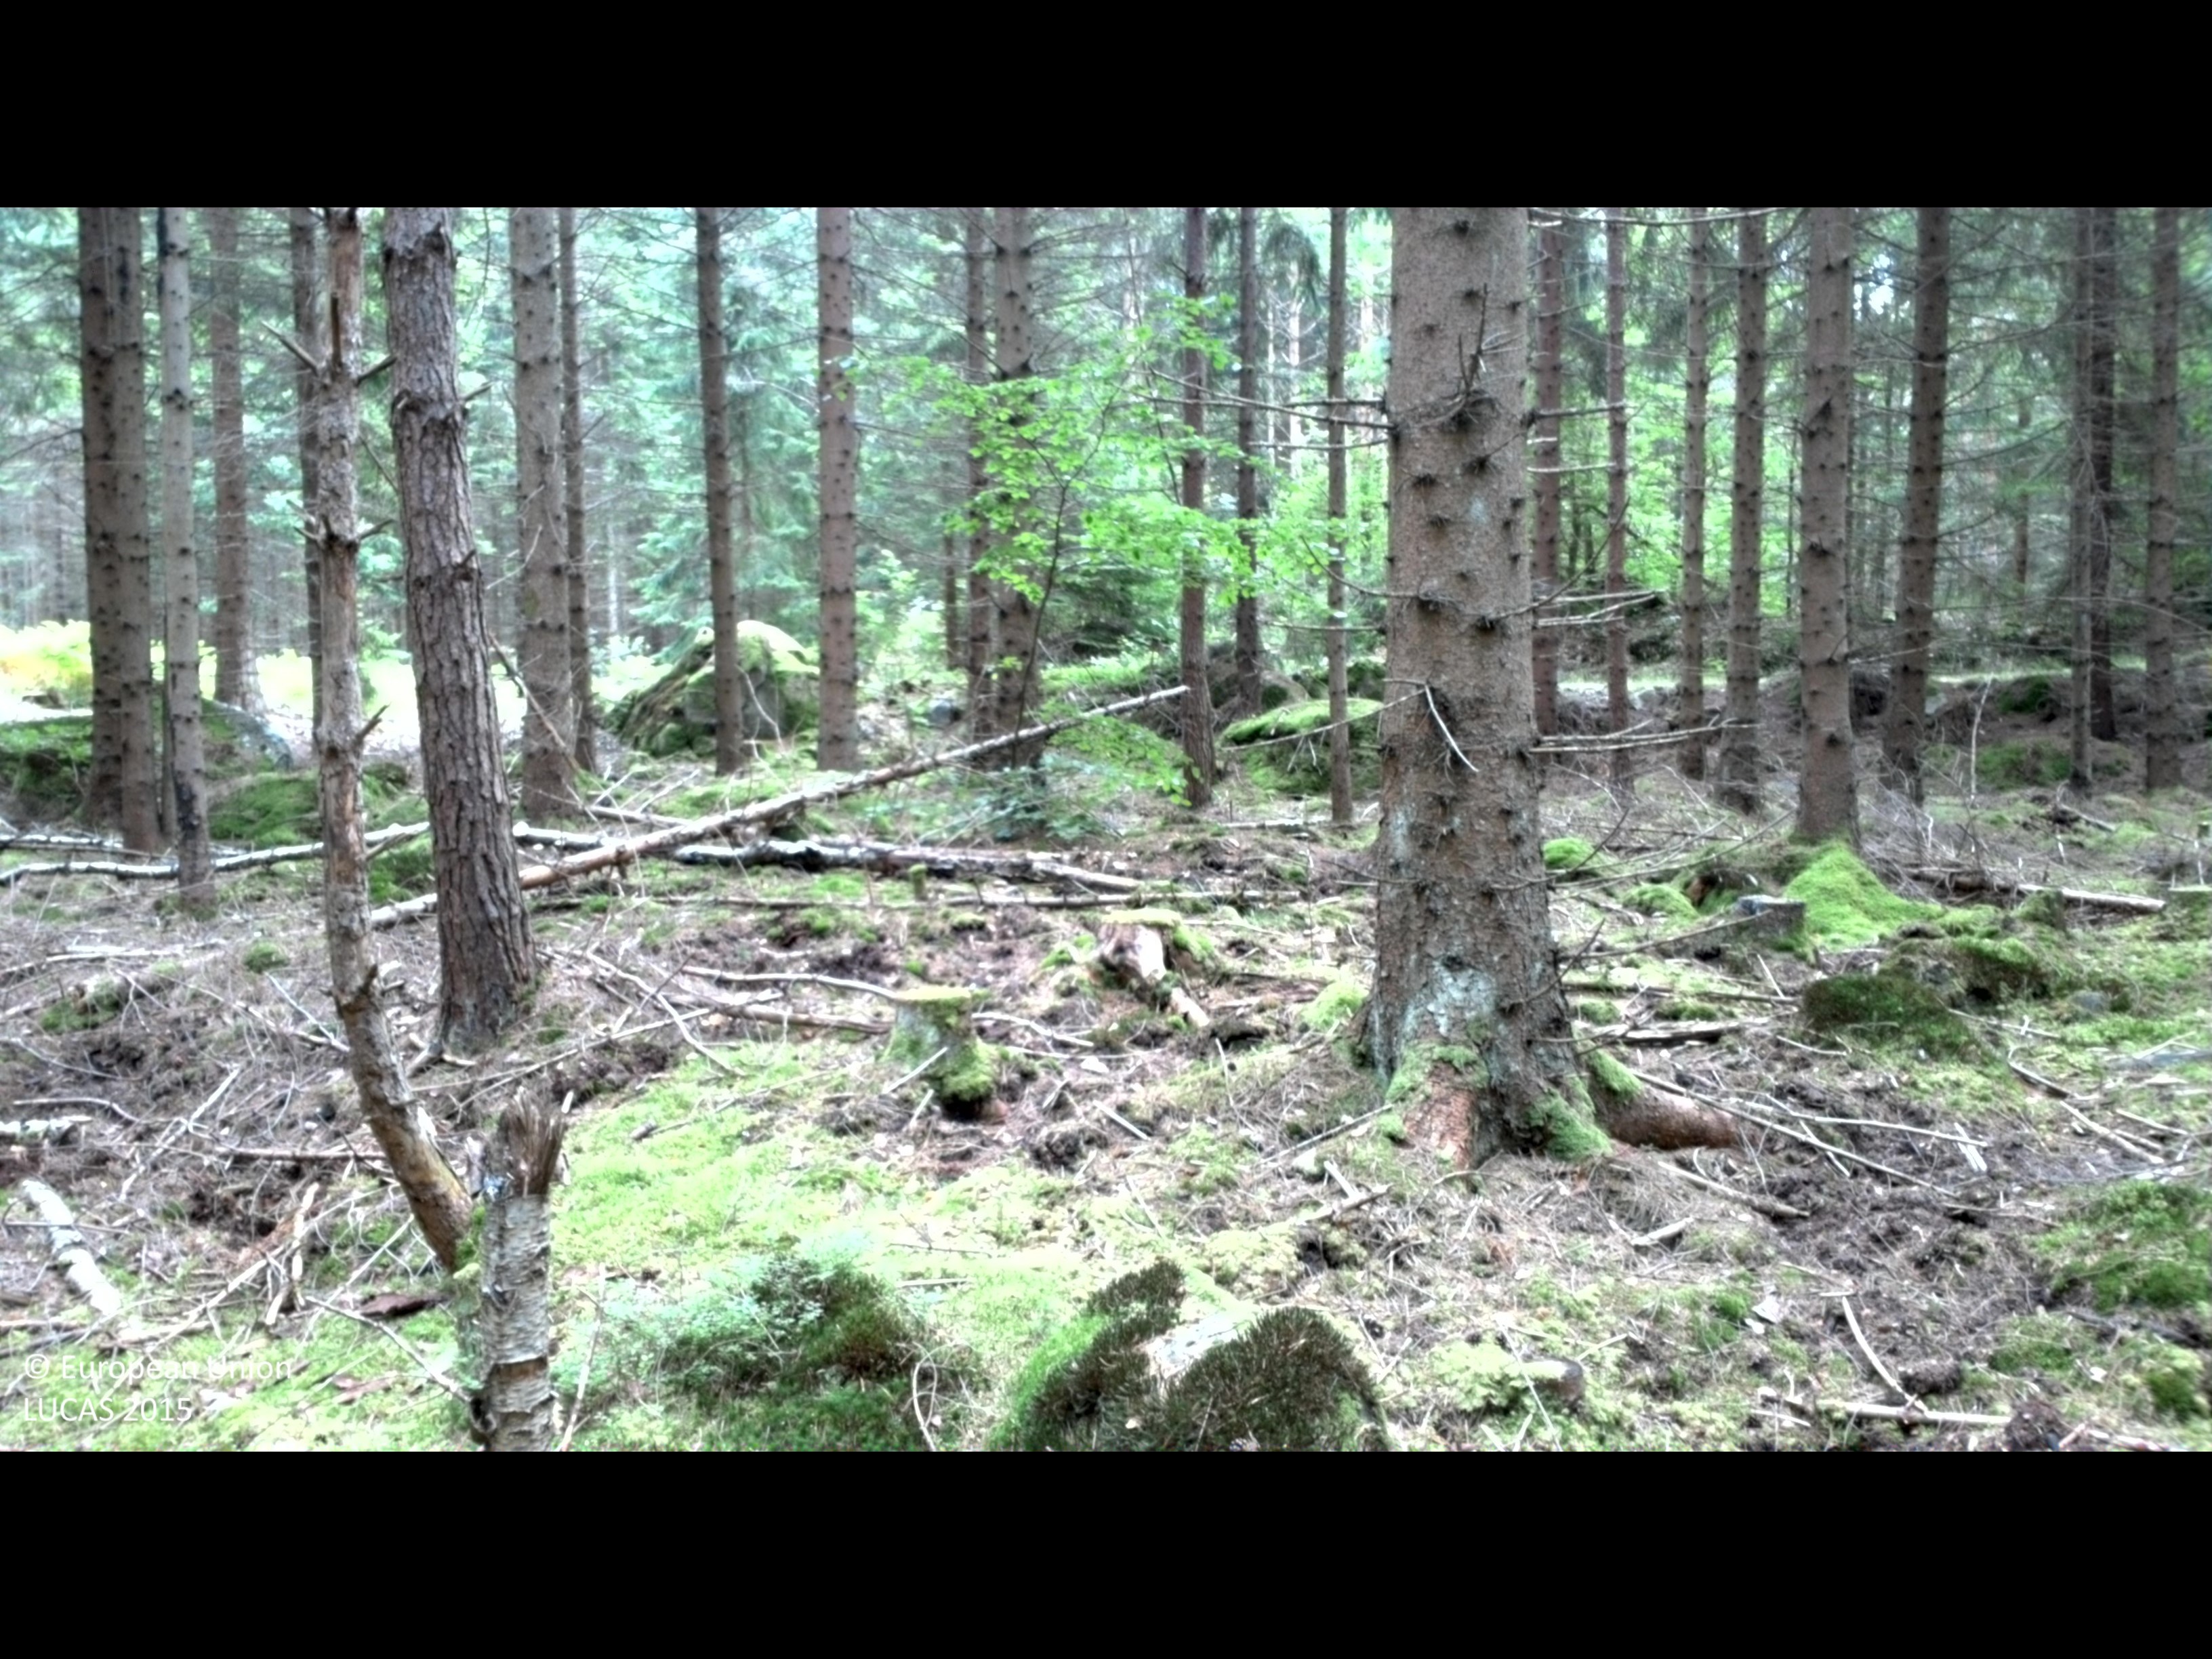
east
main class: Woodland
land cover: Spruce dominated coniferous woodland
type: boreal forest
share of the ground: 50 - 75 %
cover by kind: coniferous forest trees 65 %, lichens and mosses 35 %
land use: Forestry
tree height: > 5 m
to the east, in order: Spruce dominated coniferous woodland; Tracks; Spruce dominated coniferous woodland; Ditches and canals; Spruce dominated coniferous woodland; Pine dominated coniferous woodland
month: August
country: SE
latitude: 56.3389
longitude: 15.0942
